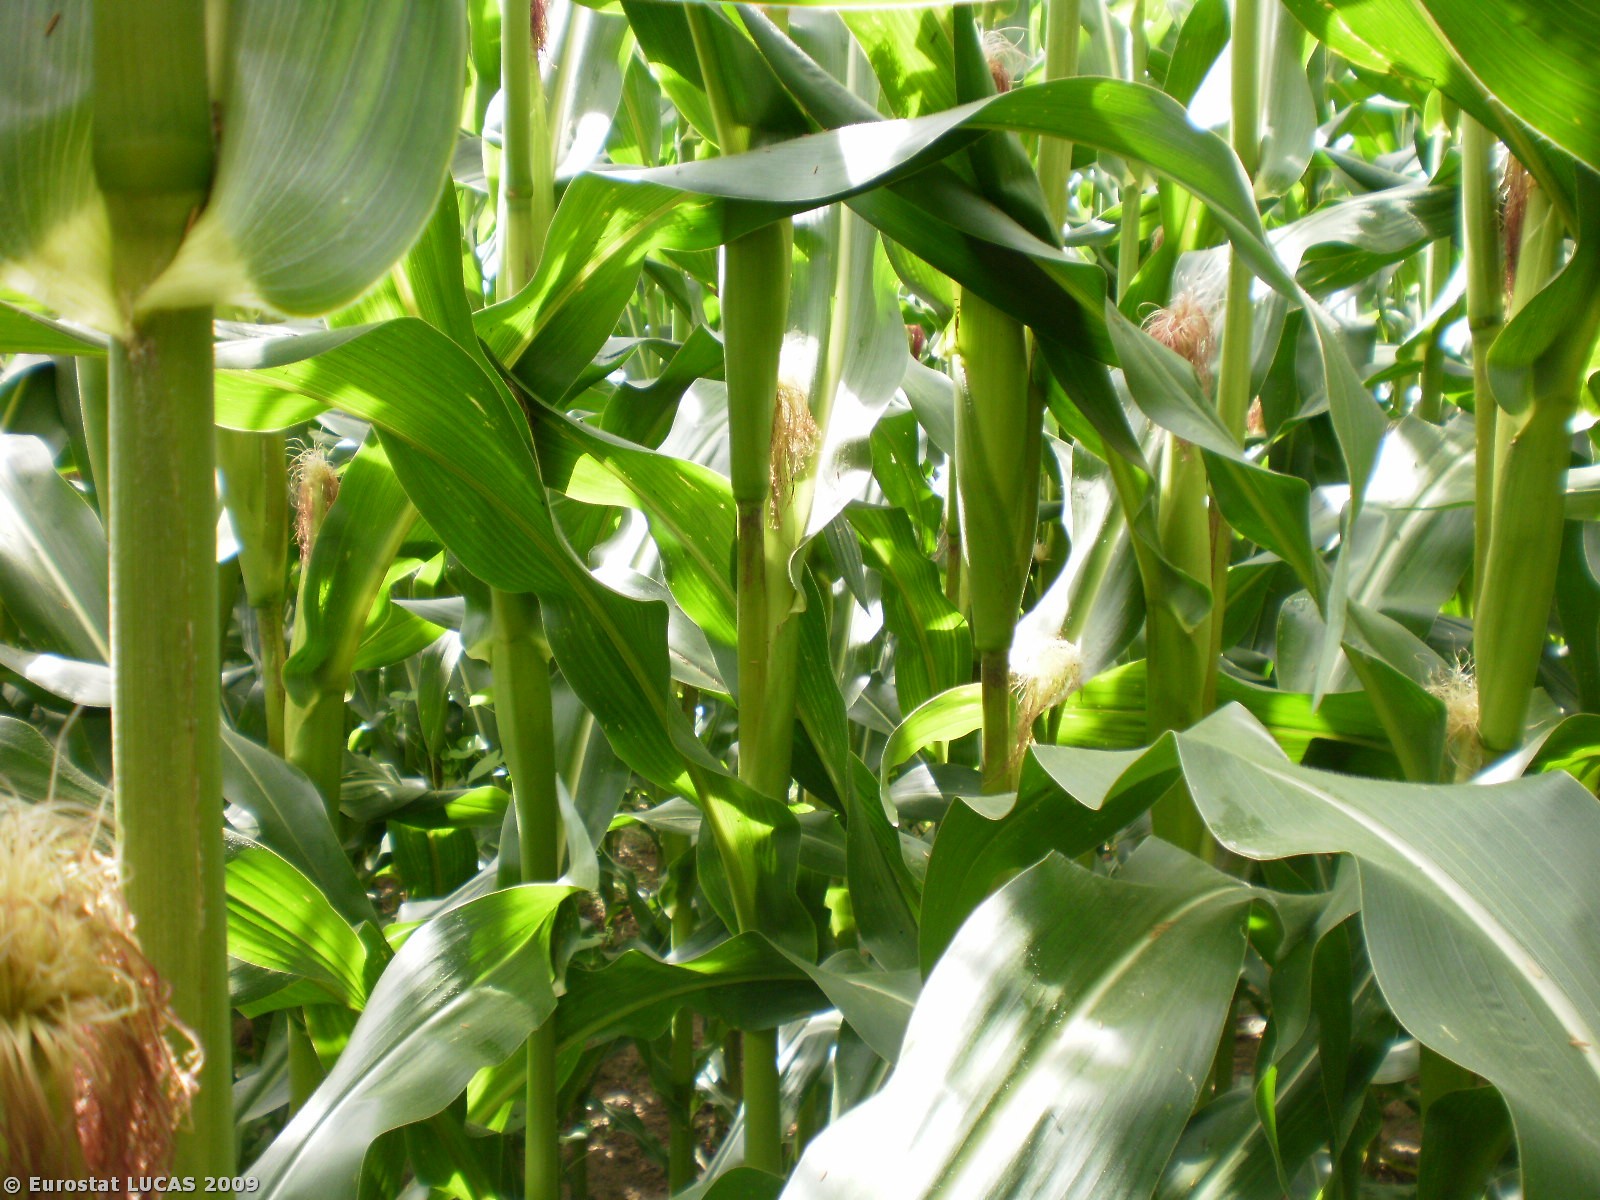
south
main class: Cropland
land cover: Maize
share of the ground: > 75 %
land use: Agriculture (excluding fallow land and kitchen gardens)
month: July
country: BE
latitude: 50.7885
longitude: 2.8255
